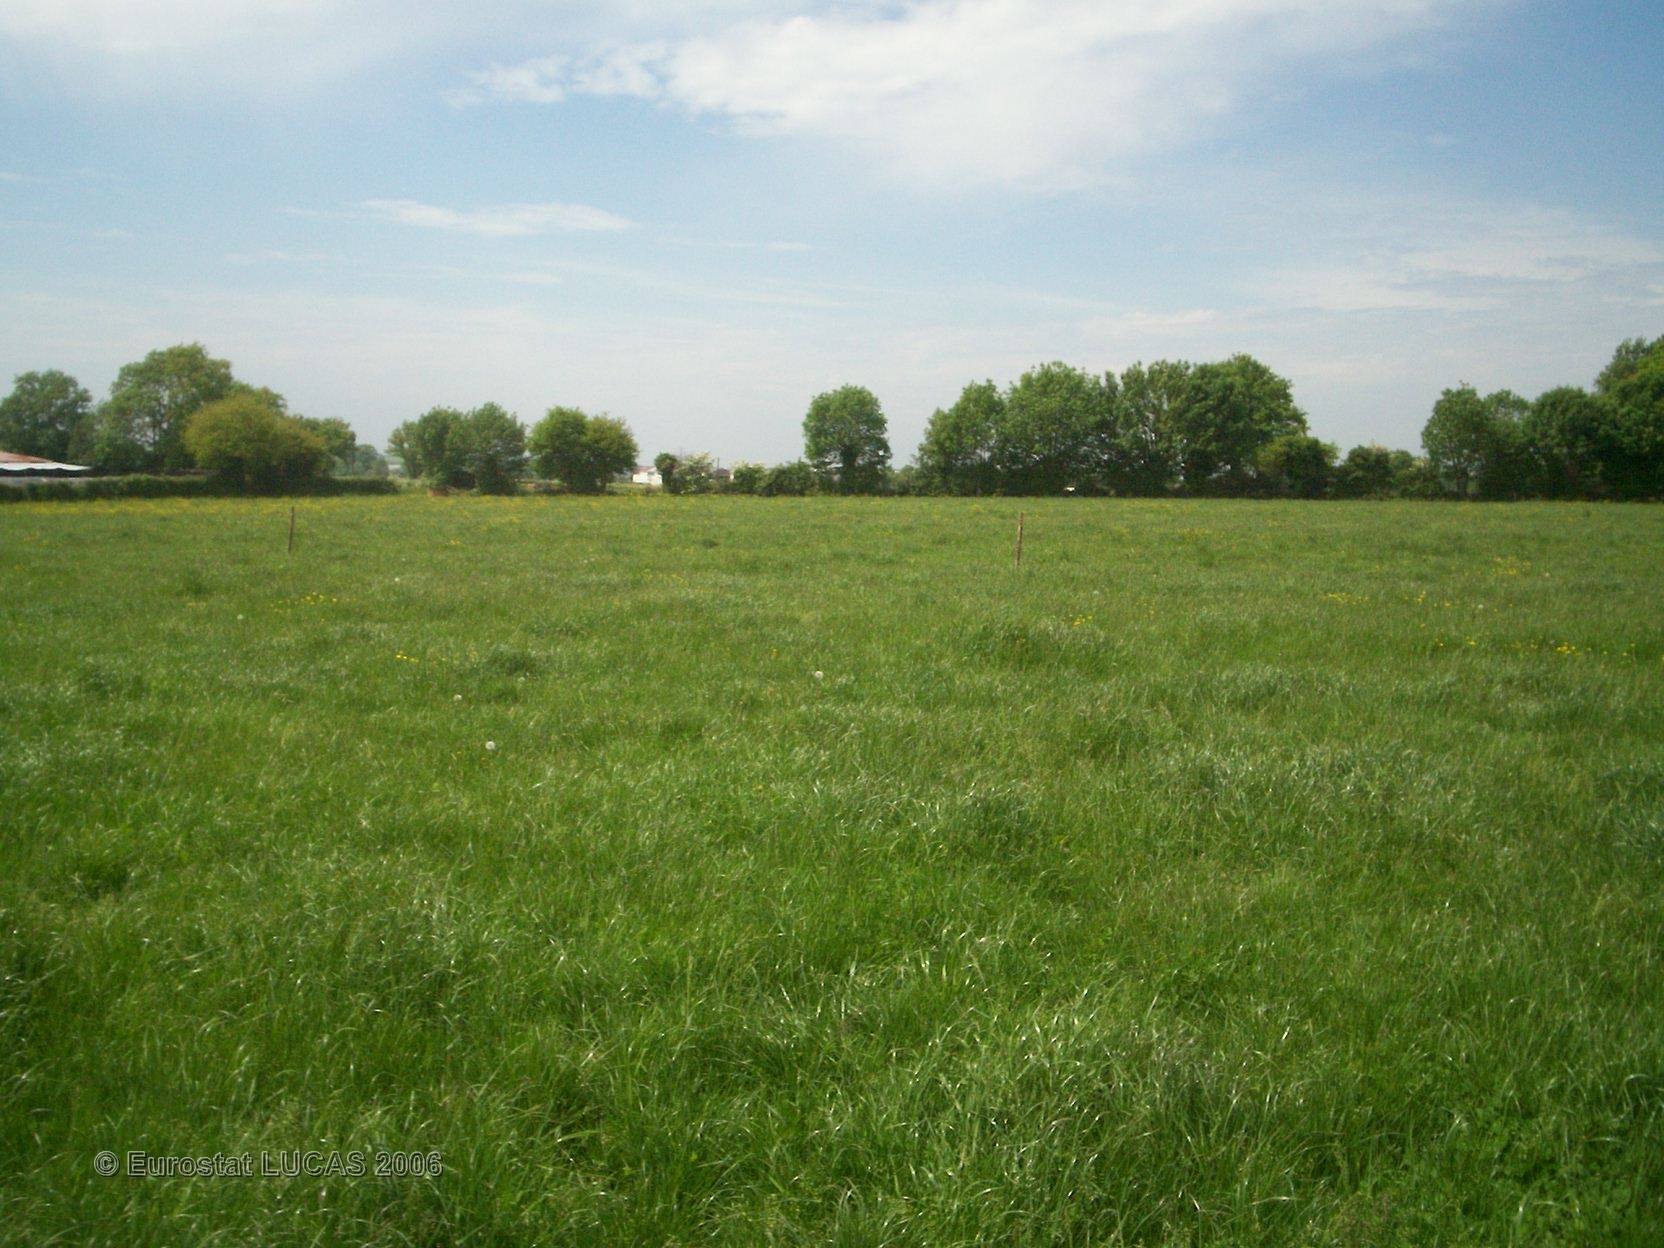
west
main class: Grassland
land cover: Grassland without tree/shrub cover
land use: Agriculture (excluding fallow land and kitchen gardens)
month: May
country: FR
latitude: 46.7442
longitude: -0.8295
